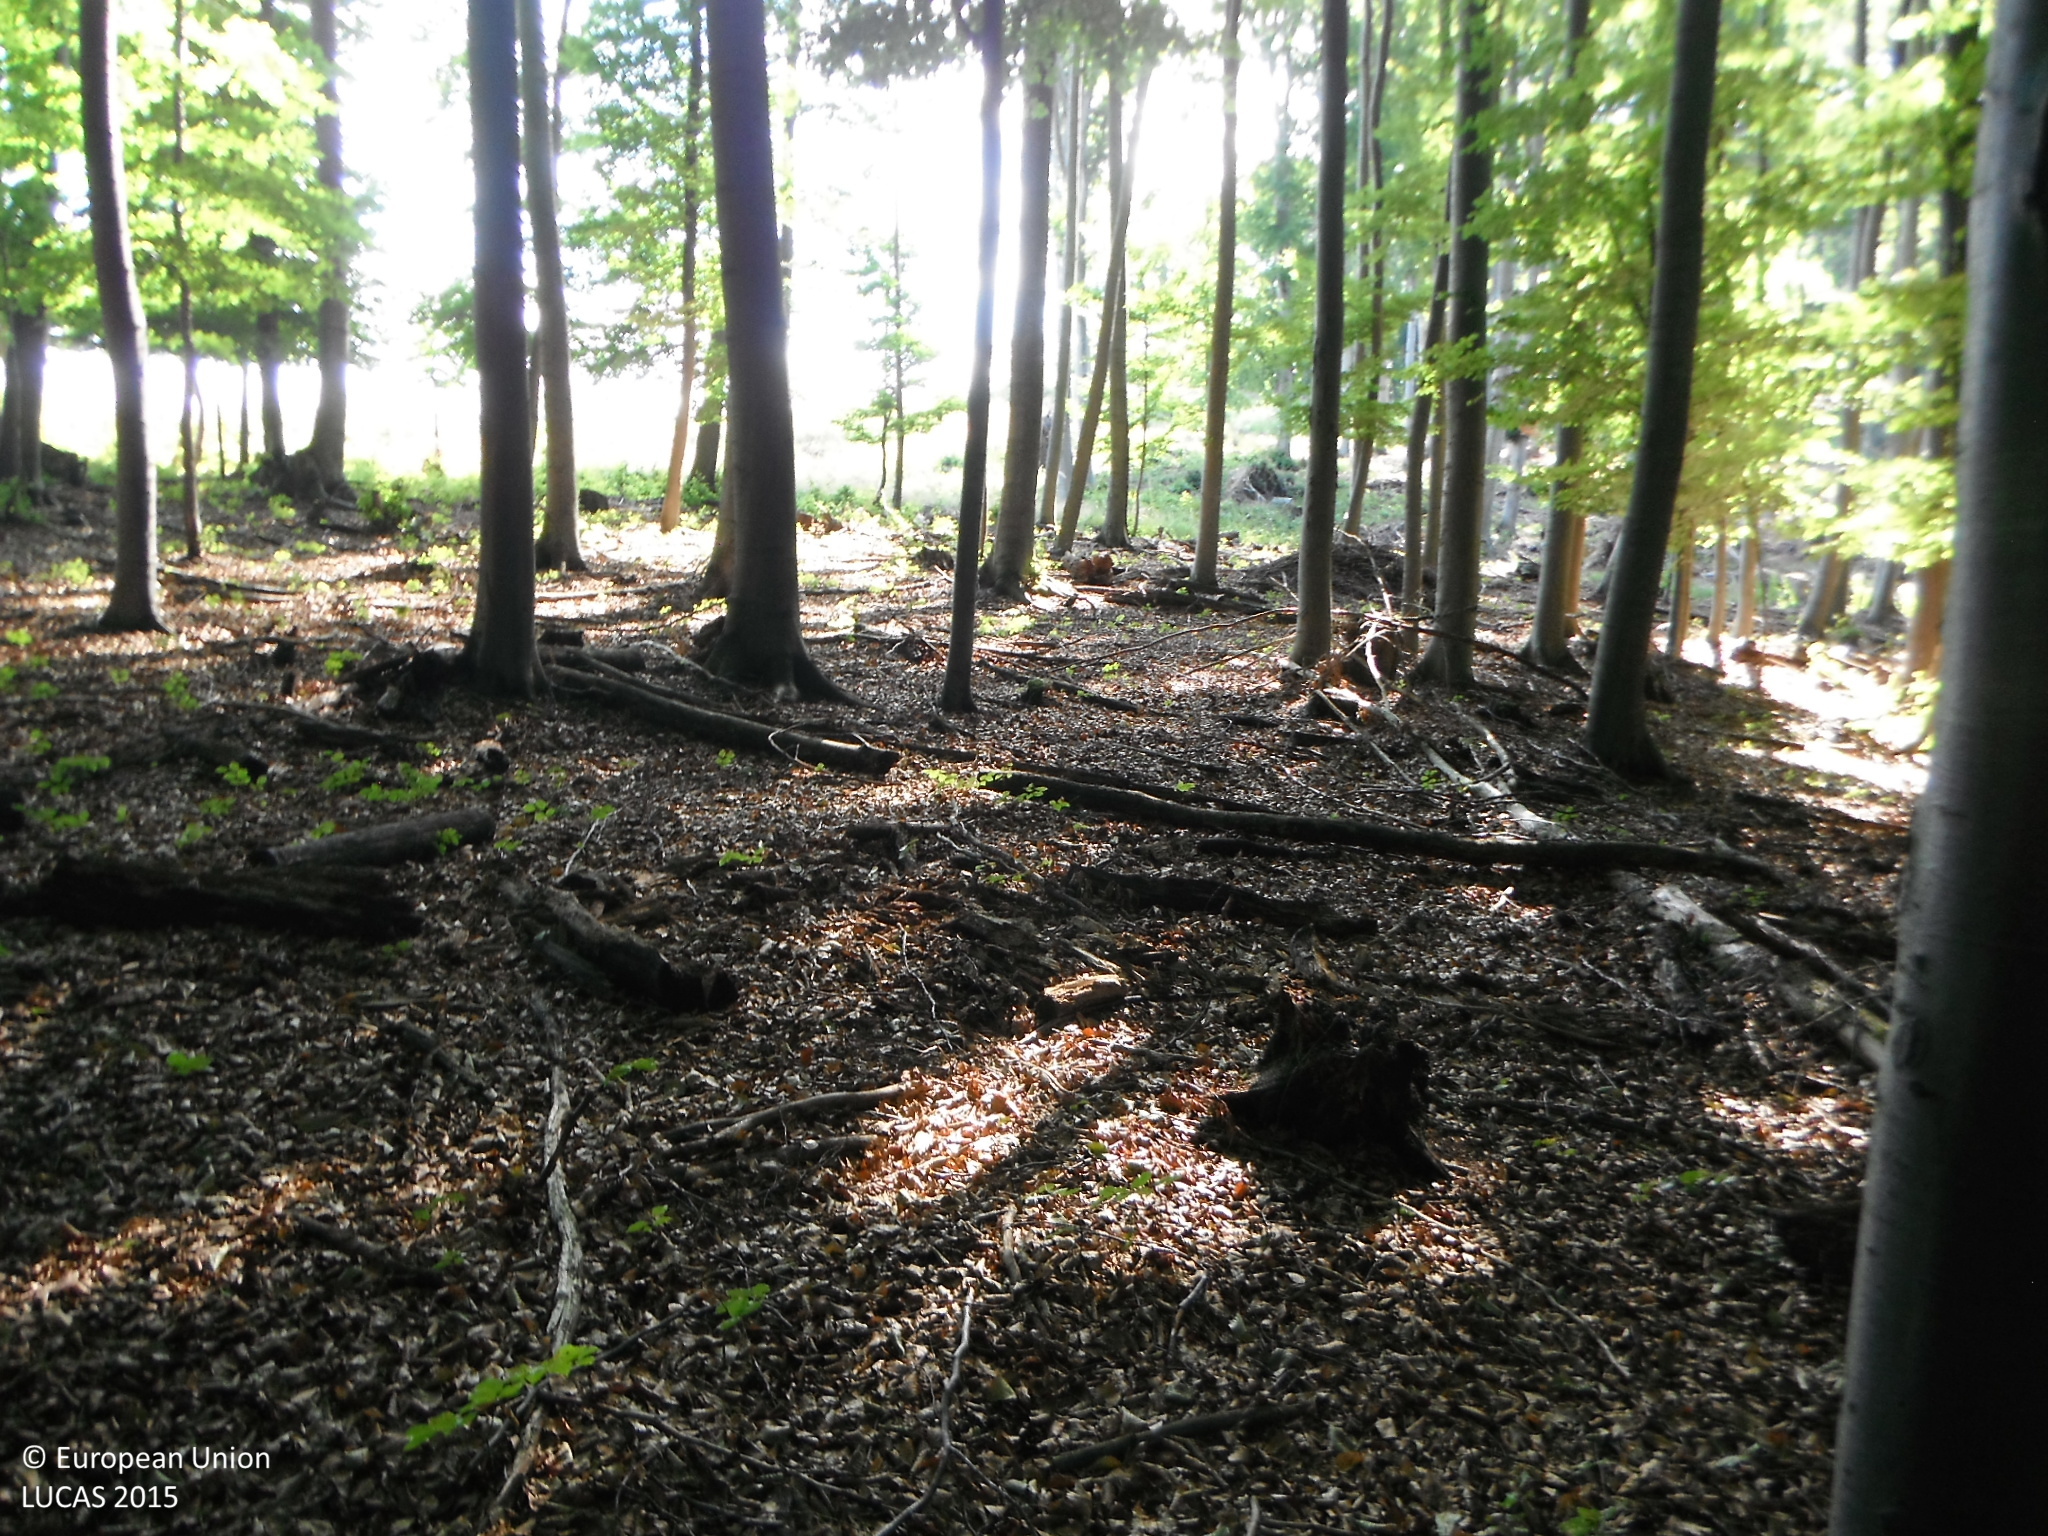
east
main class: Woodland
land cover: Broadleaved woodland
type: beech forest
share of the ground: > 75 %
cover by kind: broadleaved forest trees 90 %, consolidated bare surface 5 %
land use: Forestry
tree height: > 5 m
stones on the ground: < 10 %
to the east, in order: Broadleaved woodland; Shrubland without tree cover; Tracks; Shrubland without tree cover; Grassland with sparse tree/shrub cover; Shrubland without tree cover
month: September
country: SK
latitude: 48.7959
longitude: 18.3065
